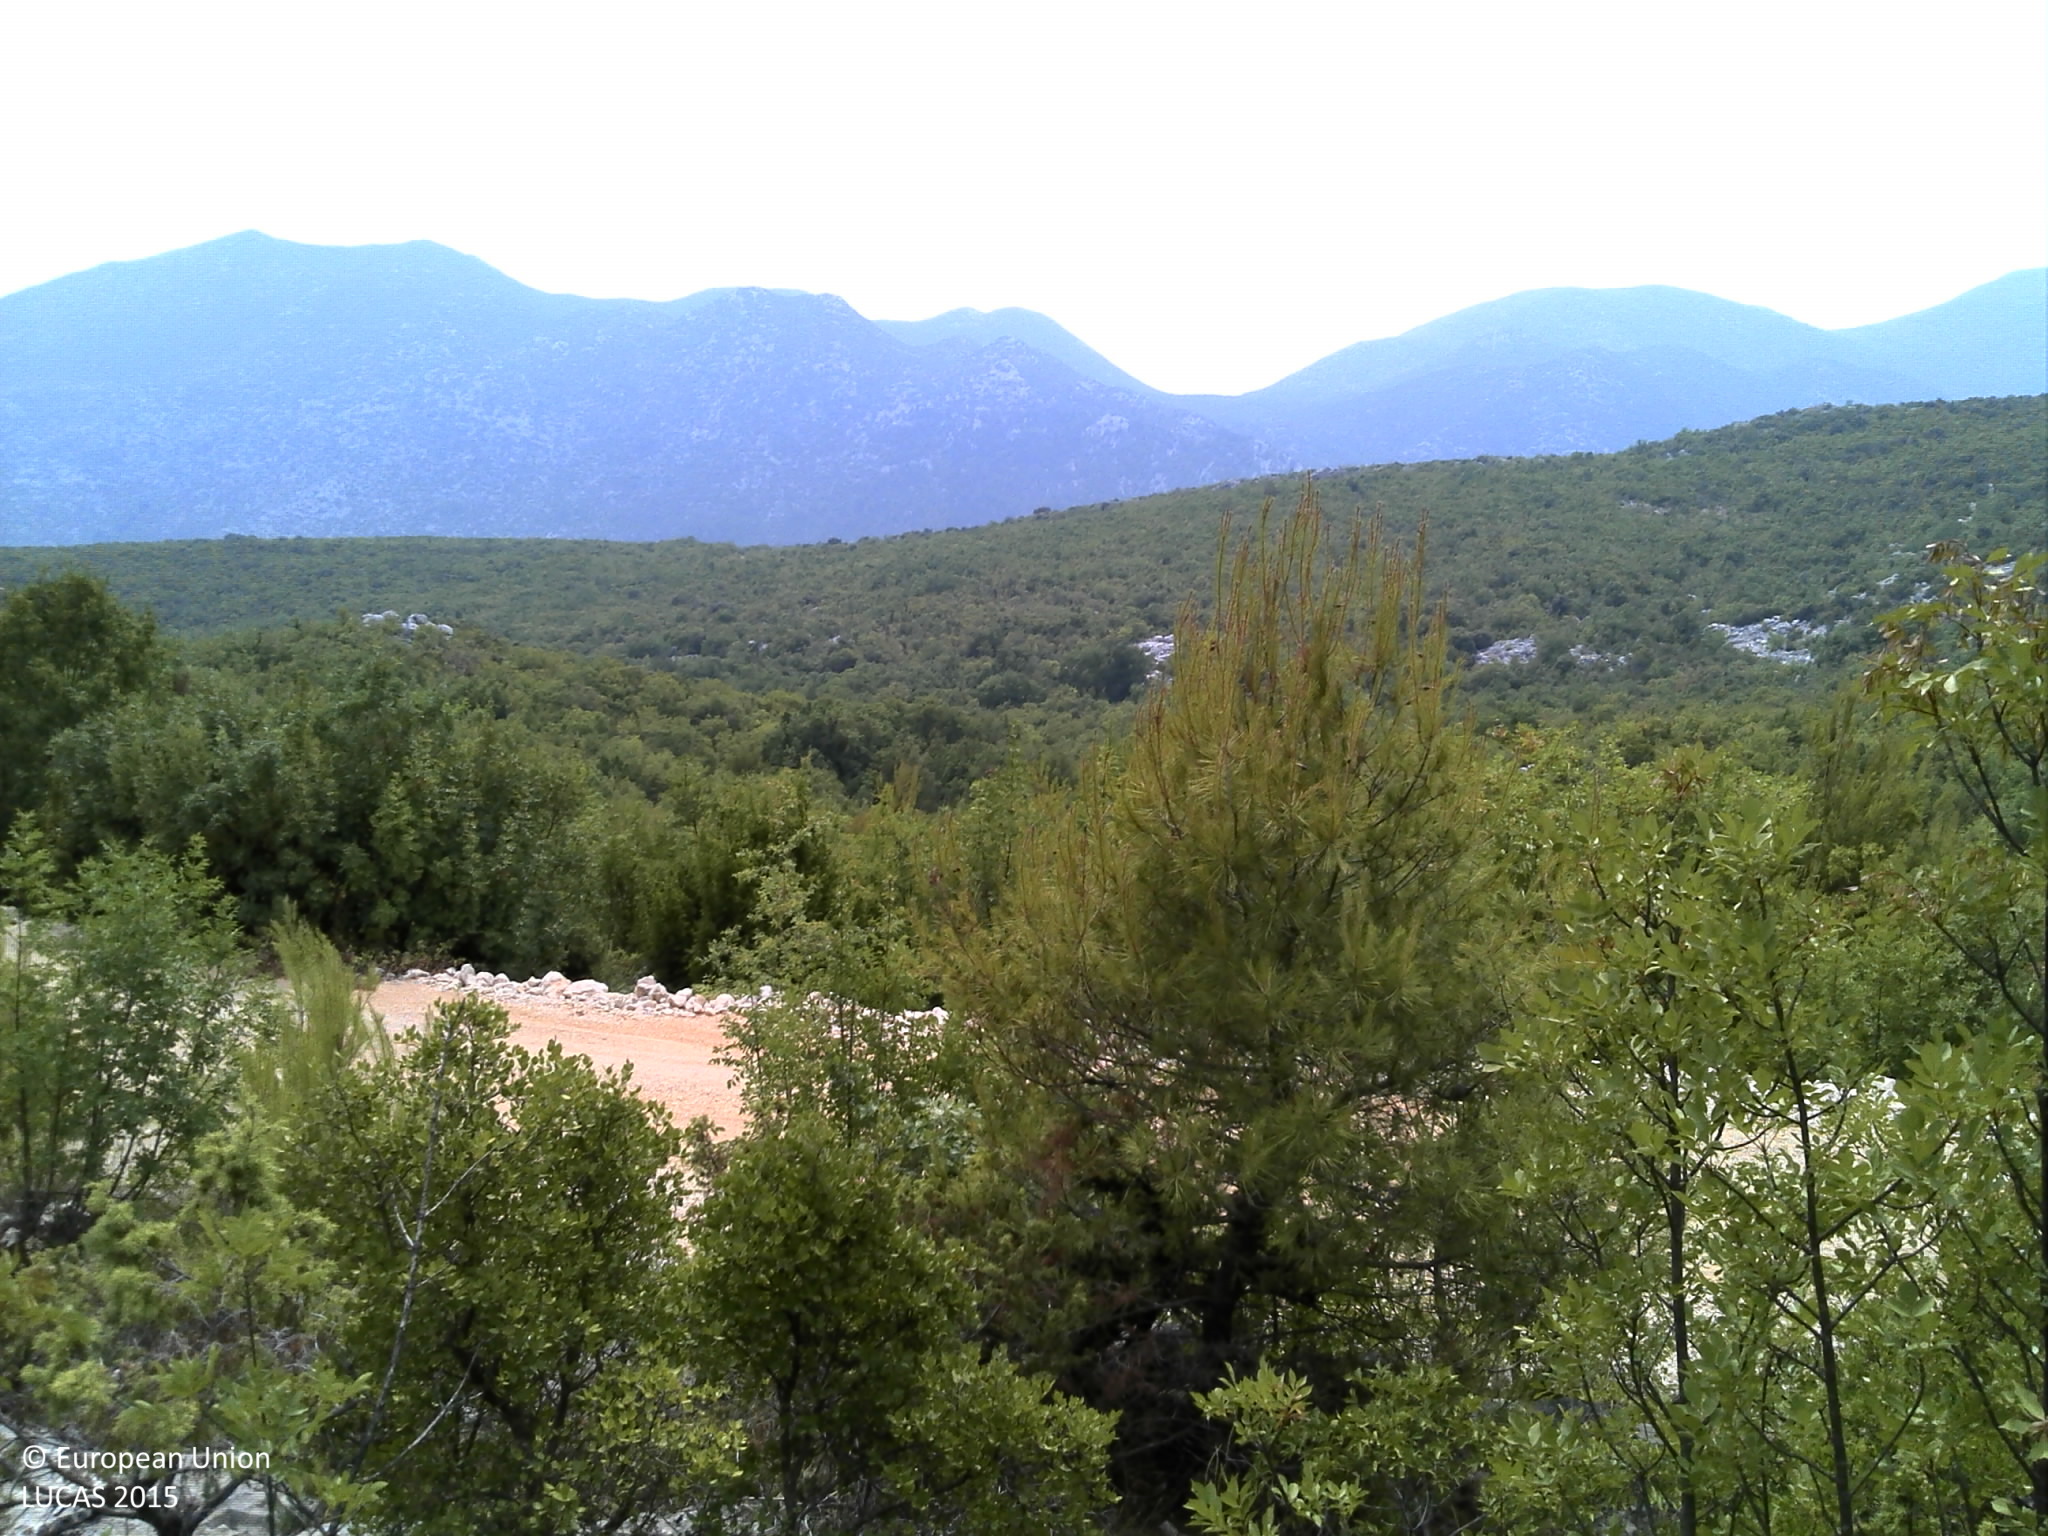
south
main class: Woodland
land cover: Pine dominated mixed woodland
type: coniferous forest of the mediterranean region
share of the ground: 50 - 75 %
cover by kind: coniferous forest trees 40 %, broadleaved forest trees 20 %, shrubs 20 %, consolidated bare surface 20 %
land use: Abandoned areas
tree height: > 5 m
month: August
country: HR
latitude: 43.0936
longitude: 17.5958
